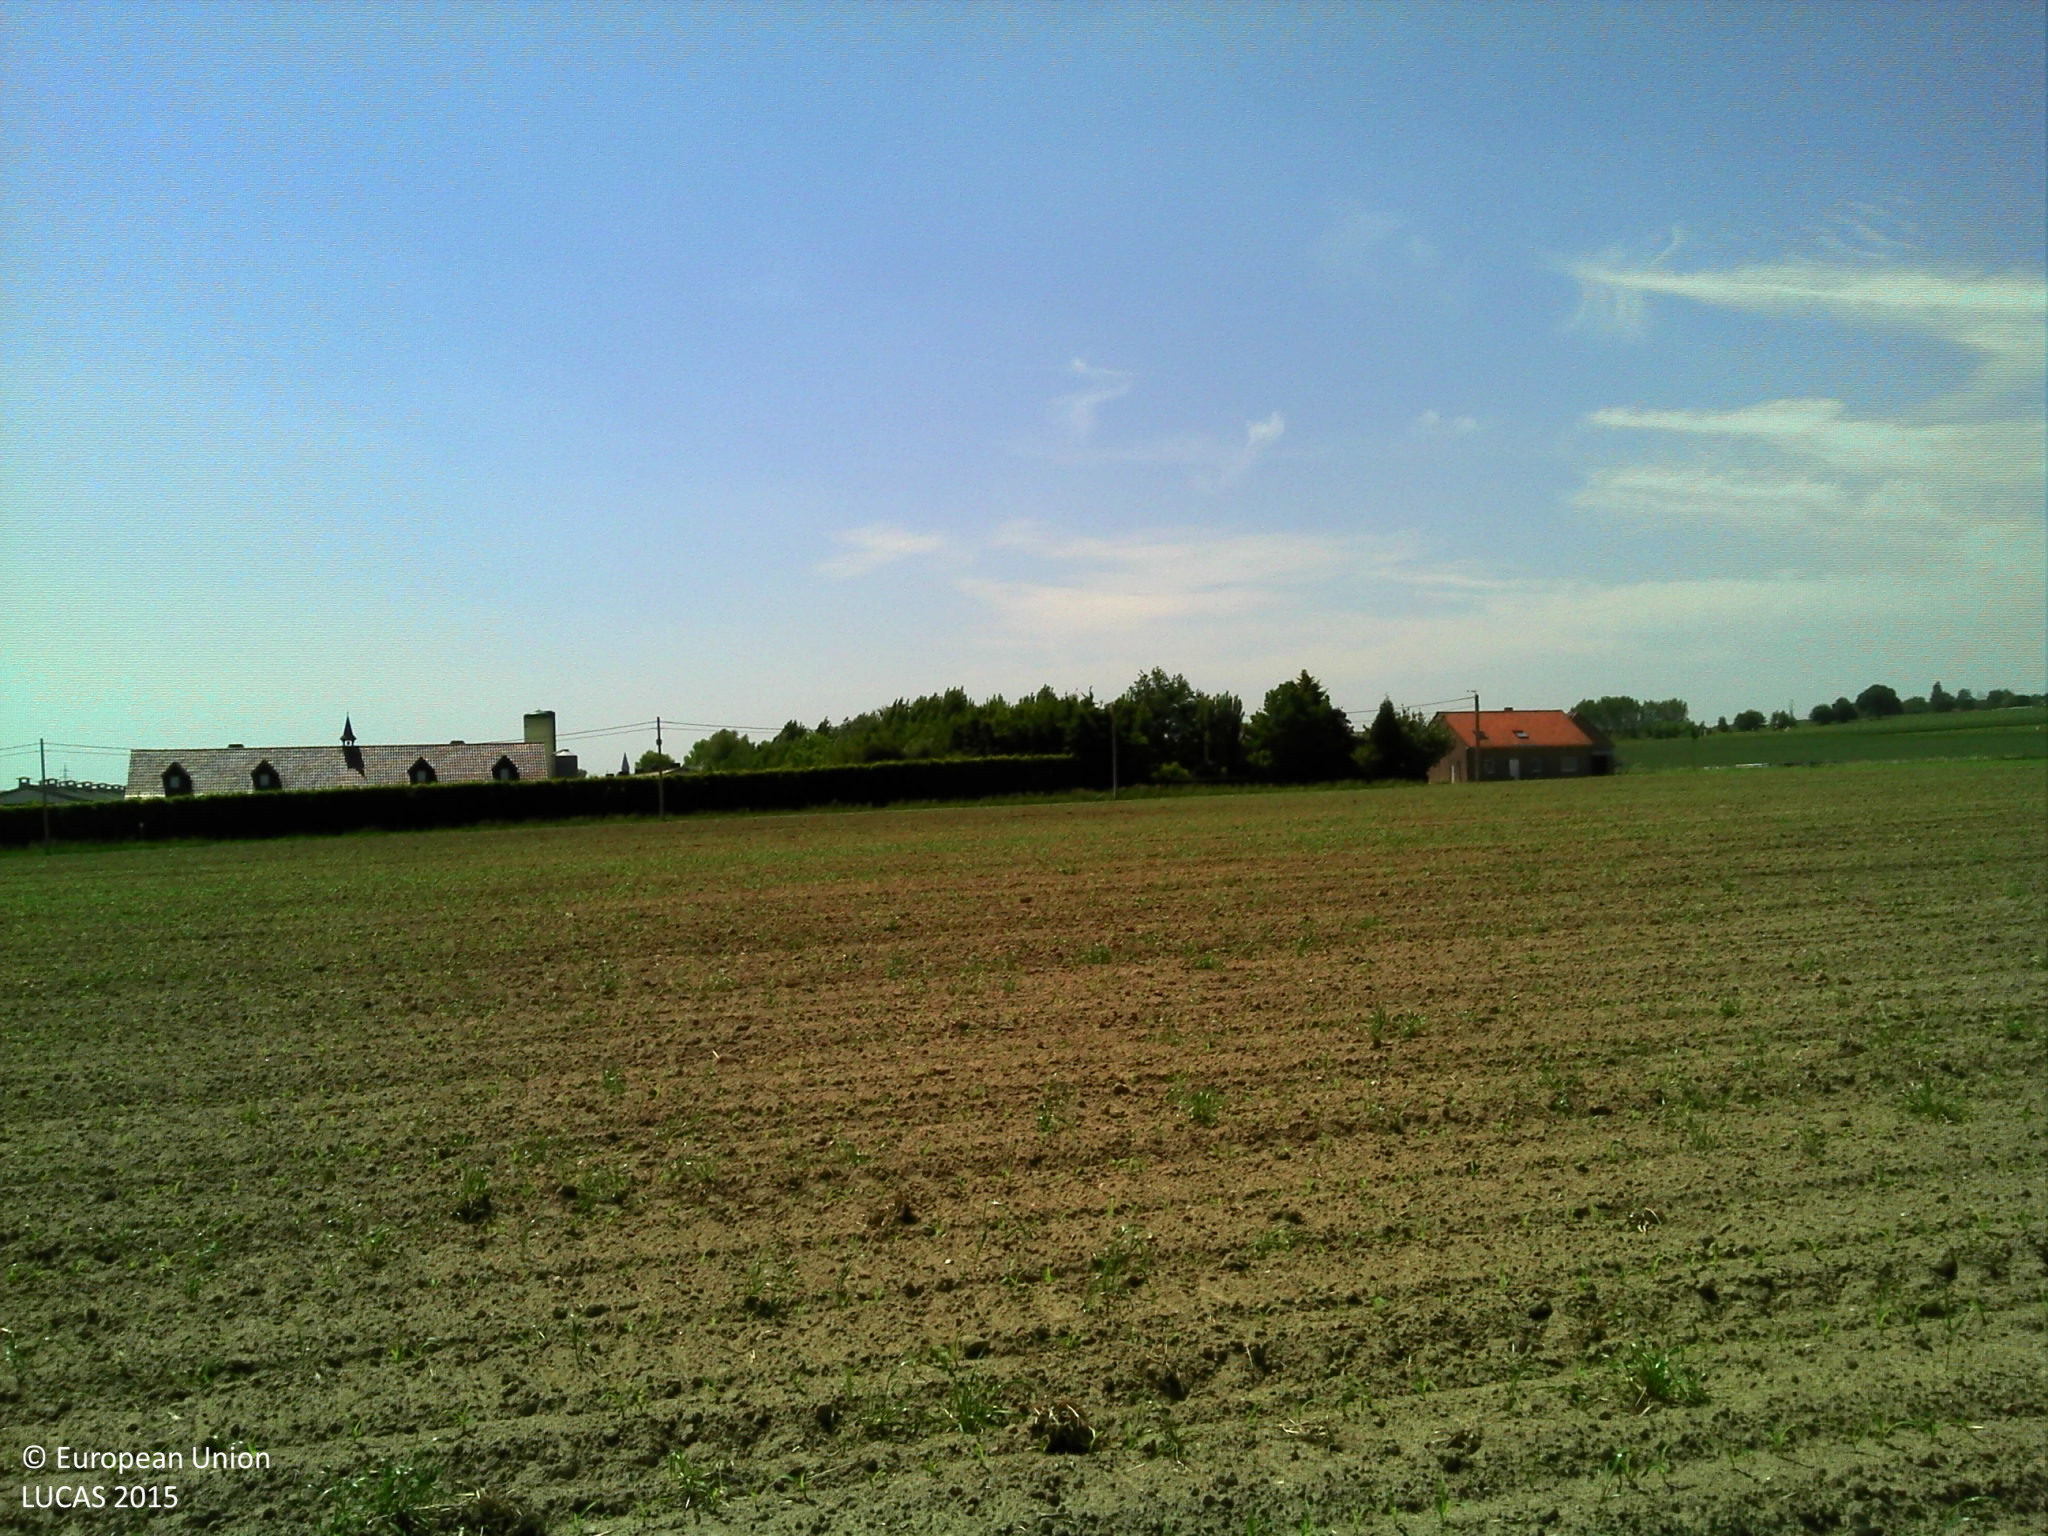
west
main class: Cropland
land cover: Maize
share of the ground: 10 - 25 %
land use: Agriculture (excluding fallow land and kitchen gardens)
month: June
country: BE
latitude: 50.8151
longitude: 2.9641
